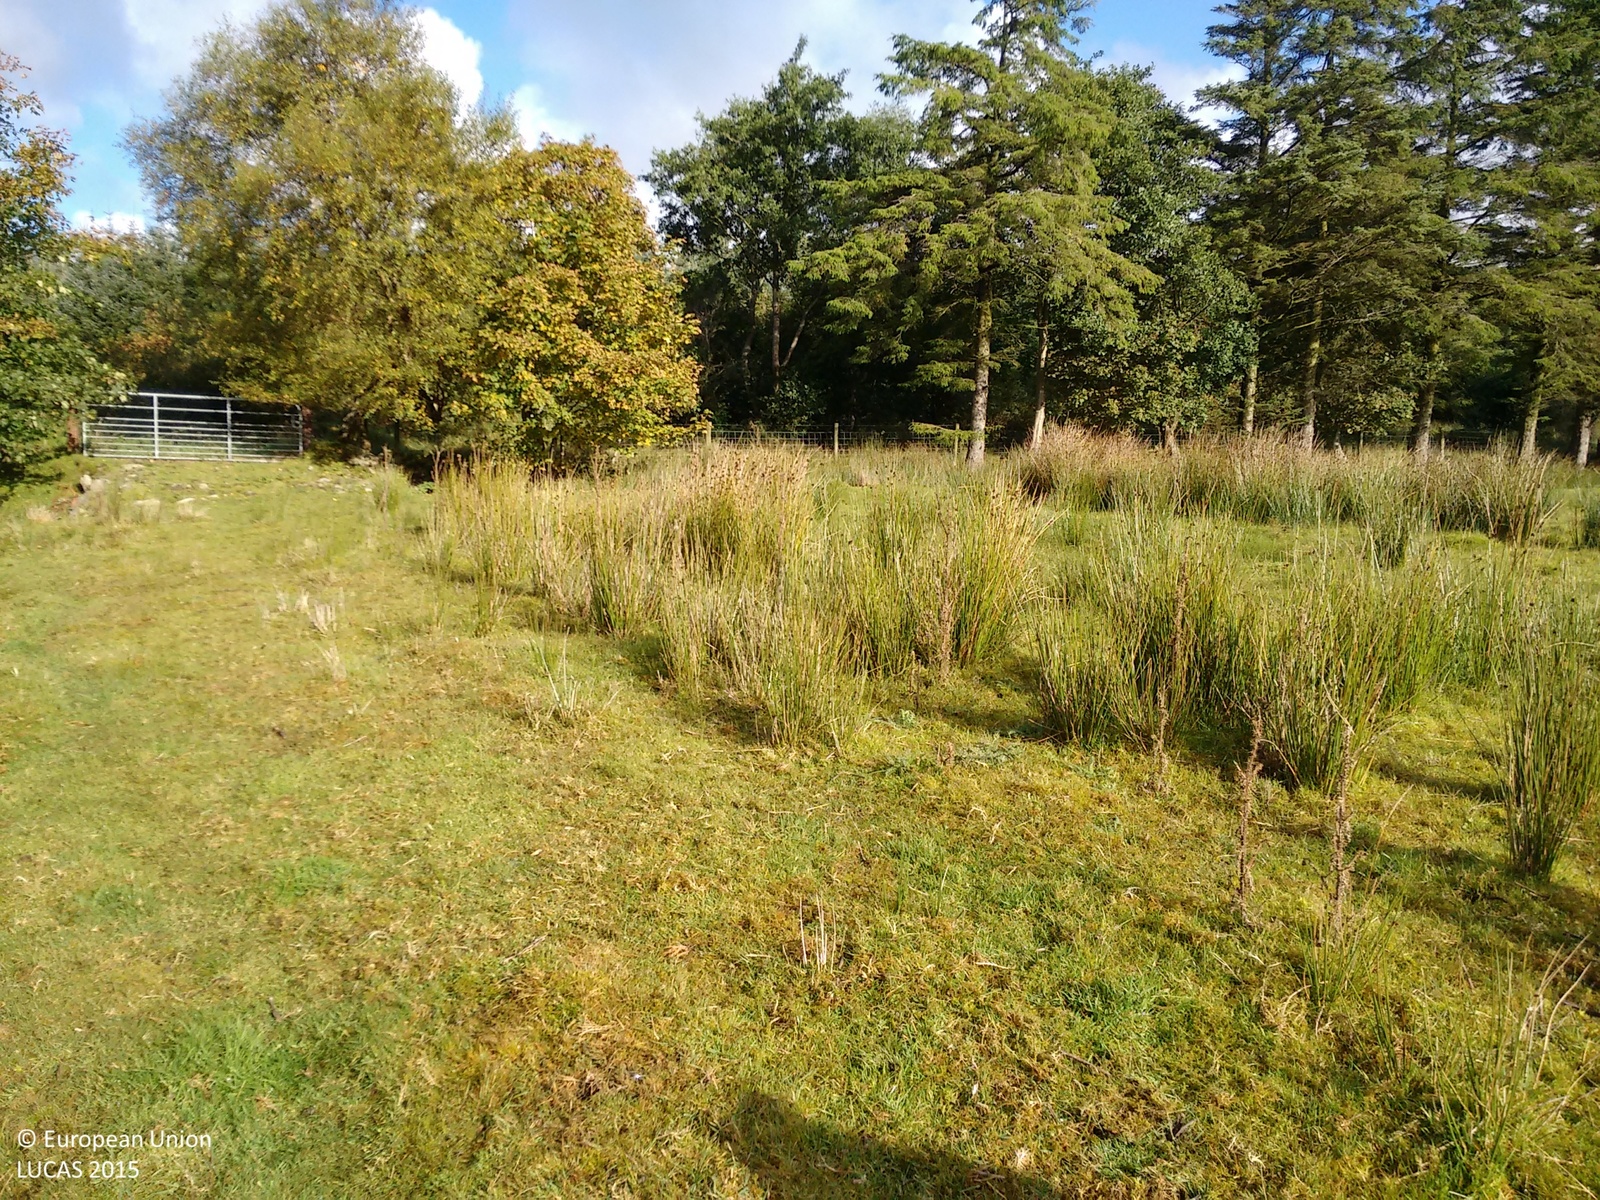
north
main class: Grassland
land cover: Grassland without tree/shrub cover
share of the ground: > 75 %
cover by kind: herbaceous plants 100 %
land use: Agriculture (excluding fallow land and kitchen gardens)
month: September
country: IE
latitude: 55.1773
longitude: -7.4722
